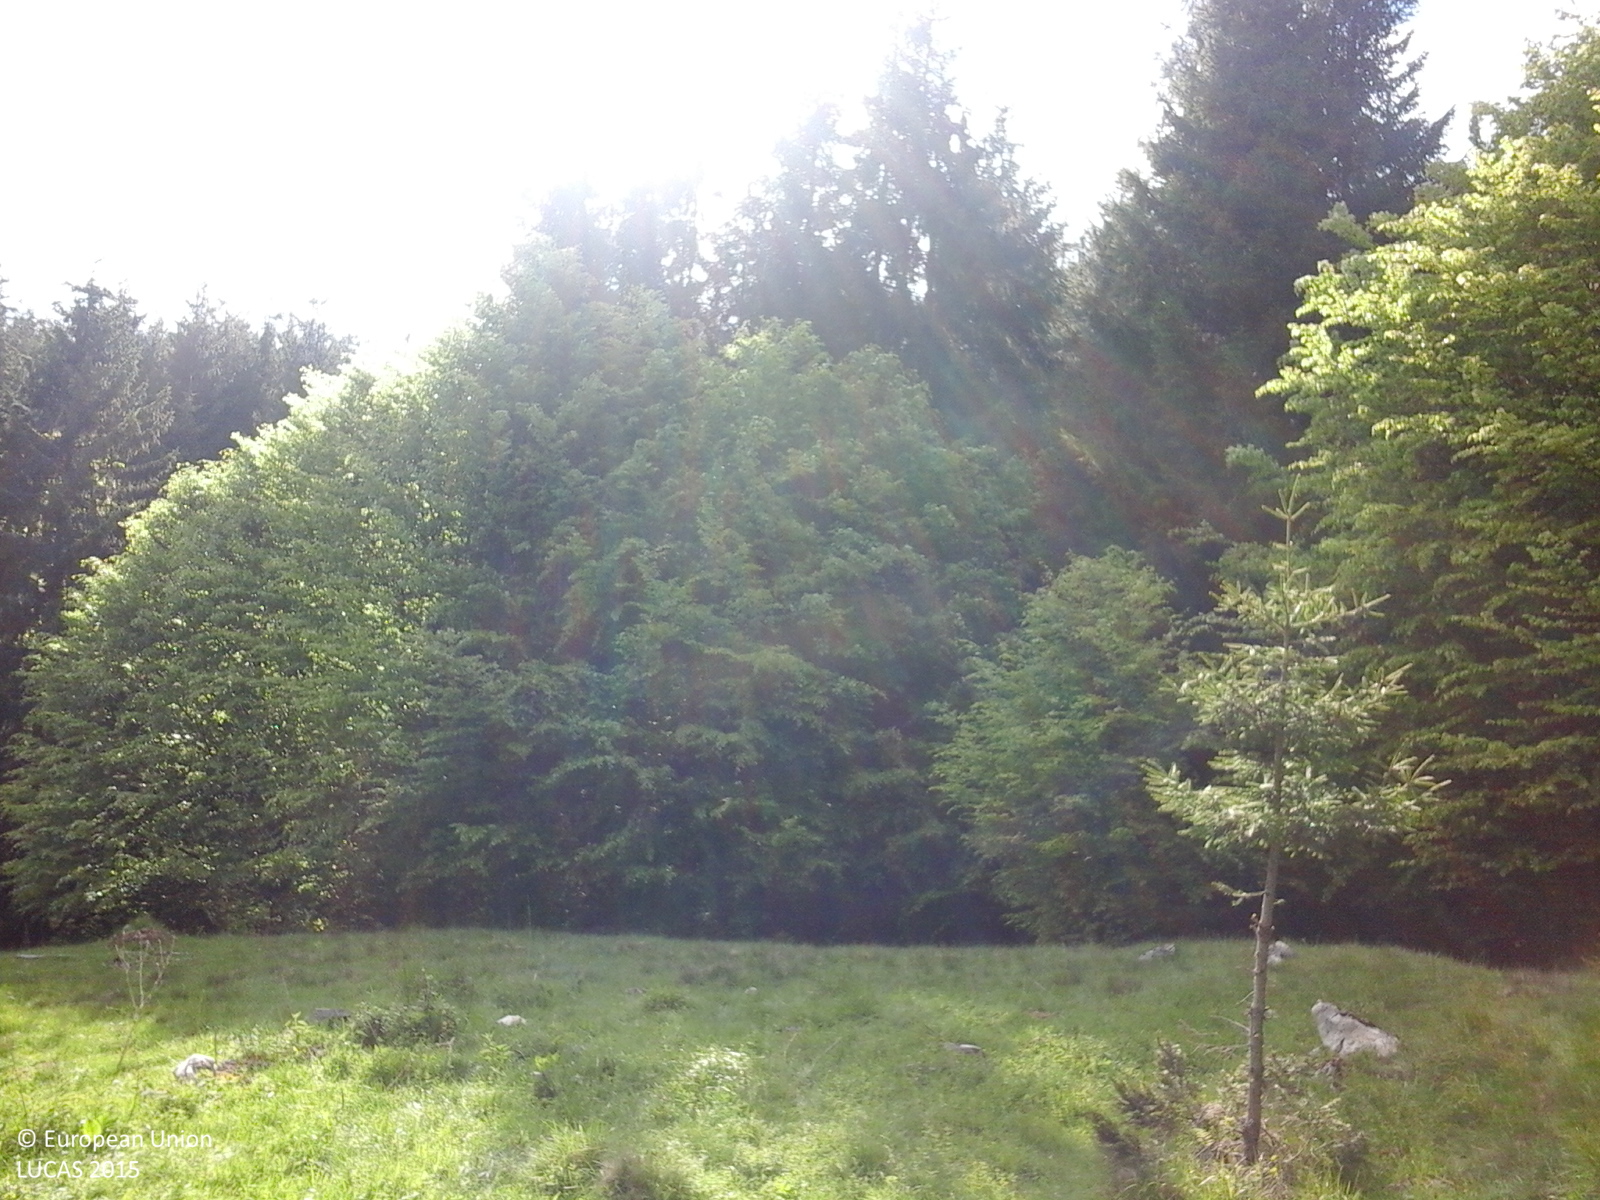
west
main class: Grassland
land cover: Grassland with sparse tree/shrub cover
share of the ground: > 75 %
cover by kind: herbaceous plants 90 %, coniferous forest trees 5 %, shrubs 5 %
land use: Forestry
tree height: < 5 m
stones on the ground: < 10 %
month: May
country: RO
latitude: 45.4904
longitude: 25.2318
